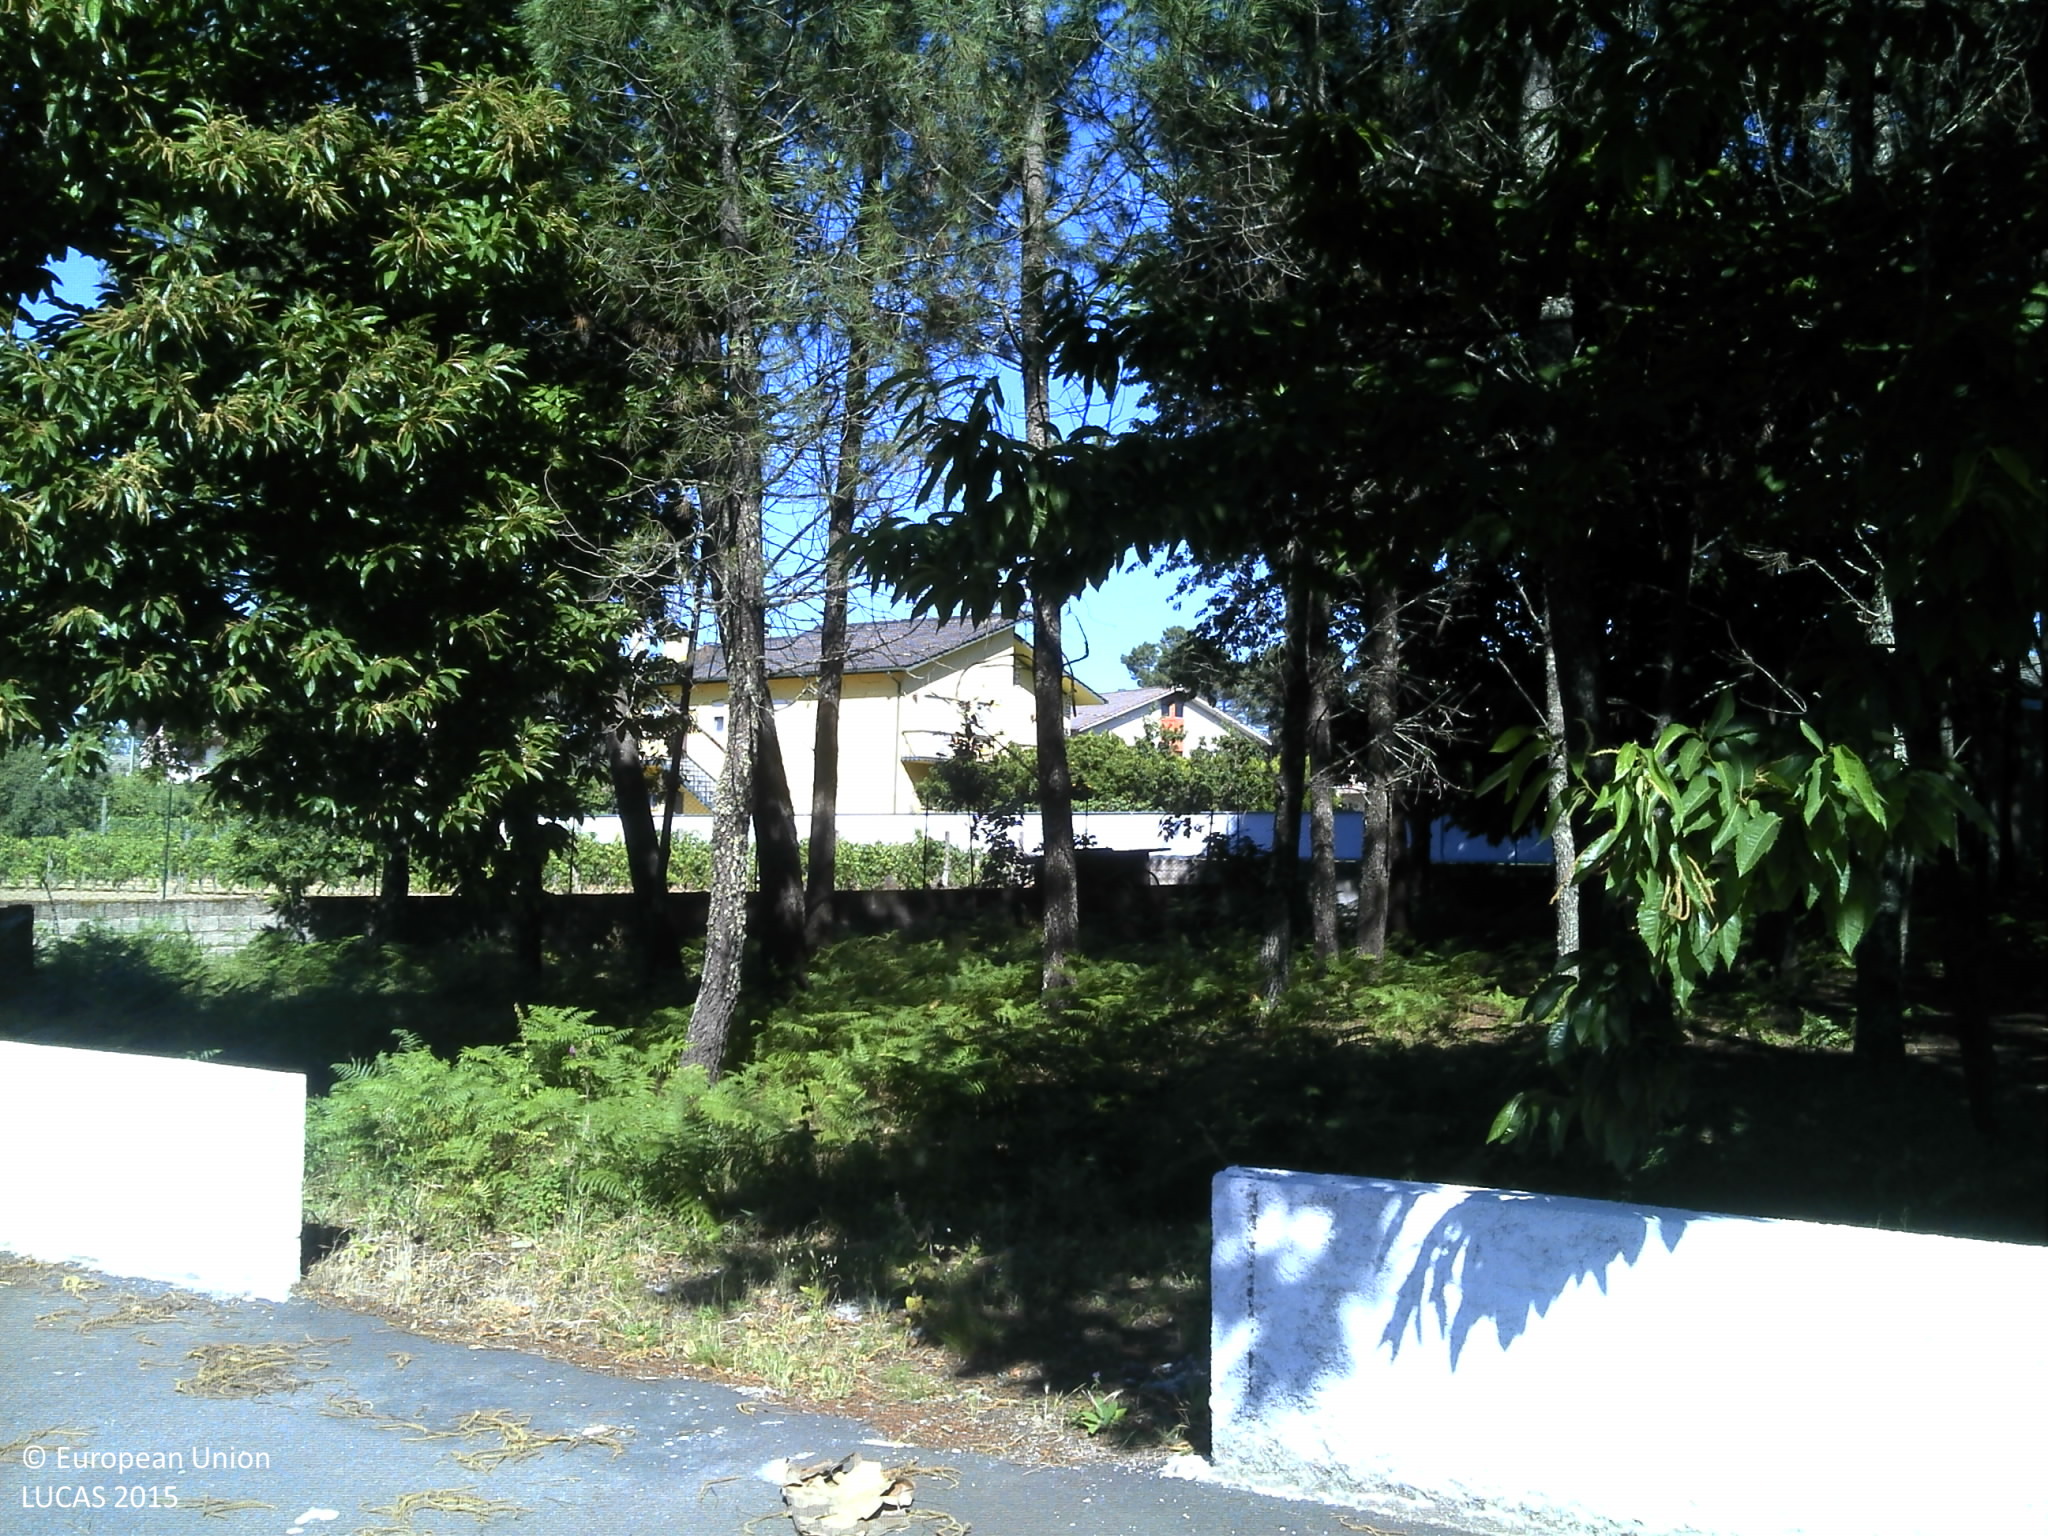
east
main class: Cropland
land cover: Potatoes
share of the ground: > 75 %
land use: Agriculture (excluding fallow land and kitchen gardens)
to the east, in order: Potatoes; Vineyards; Dry stone walls; Paved roads, cycling and walking lanes; Dry stone walls; Pine dominated coniferous woodland; Broadleaved woodland; Dry stone walls; Other bare soil; Vineyards; Artificial constructions in urban areas; Vineyards; Spontaneously vegetated surfaces; Vineyards; Electric lines; Fences; Spontaneously vegetated surfaces; Dry stone walls; Grass margins; Tracks; Grass margins; Dry stone walls; Spontaneously vegetated surfaces; Grassland with sparse tree/shrub cover; Spontaneously vegetated surfaces; Dry stone walls; Pine dominated coniferous woodland
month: June
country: PT
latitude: 40.7306
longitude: -7.8977
